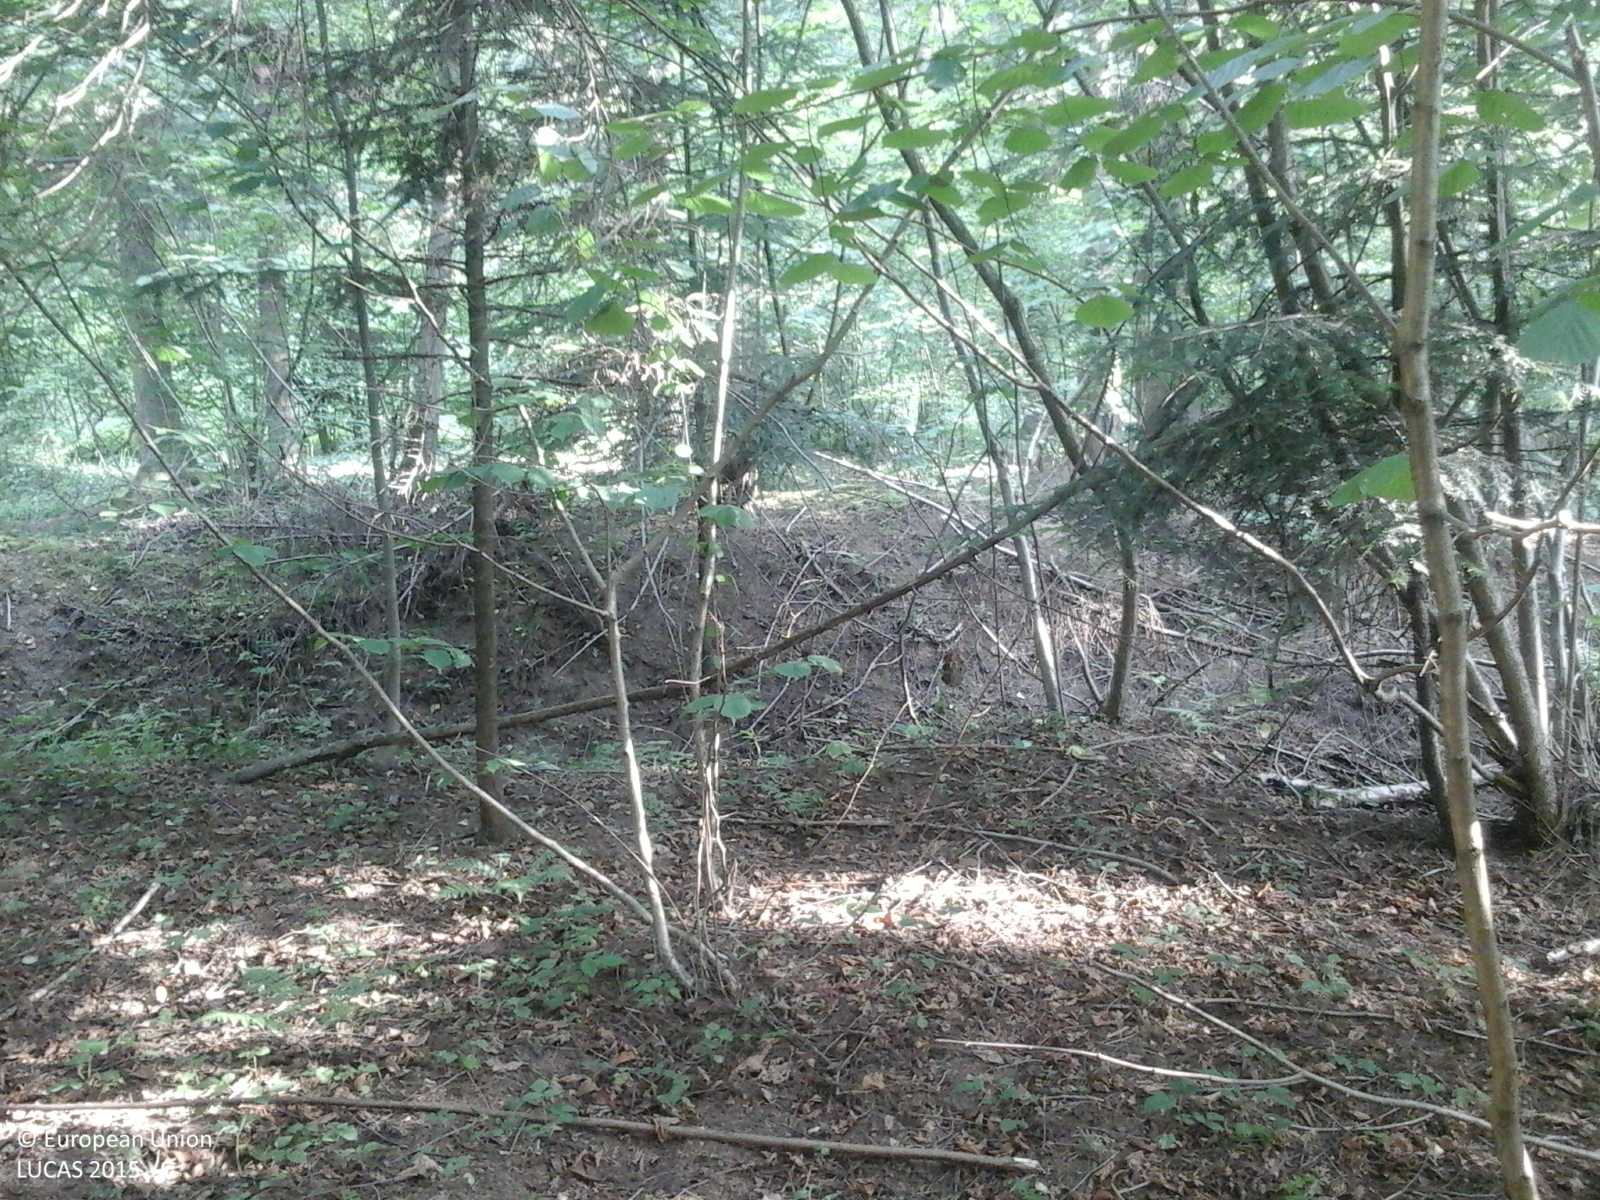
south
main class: Woodland
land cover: Spruce dominated mixed woodland
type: alpine coniferous forest
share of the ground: > 75 %
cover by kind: coniferous forest trees 75 %, broadleaved forest trees 25 %
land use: Forestry
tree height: > 5 m
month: June
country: RO
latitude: 47.6929
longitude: 25.8347
